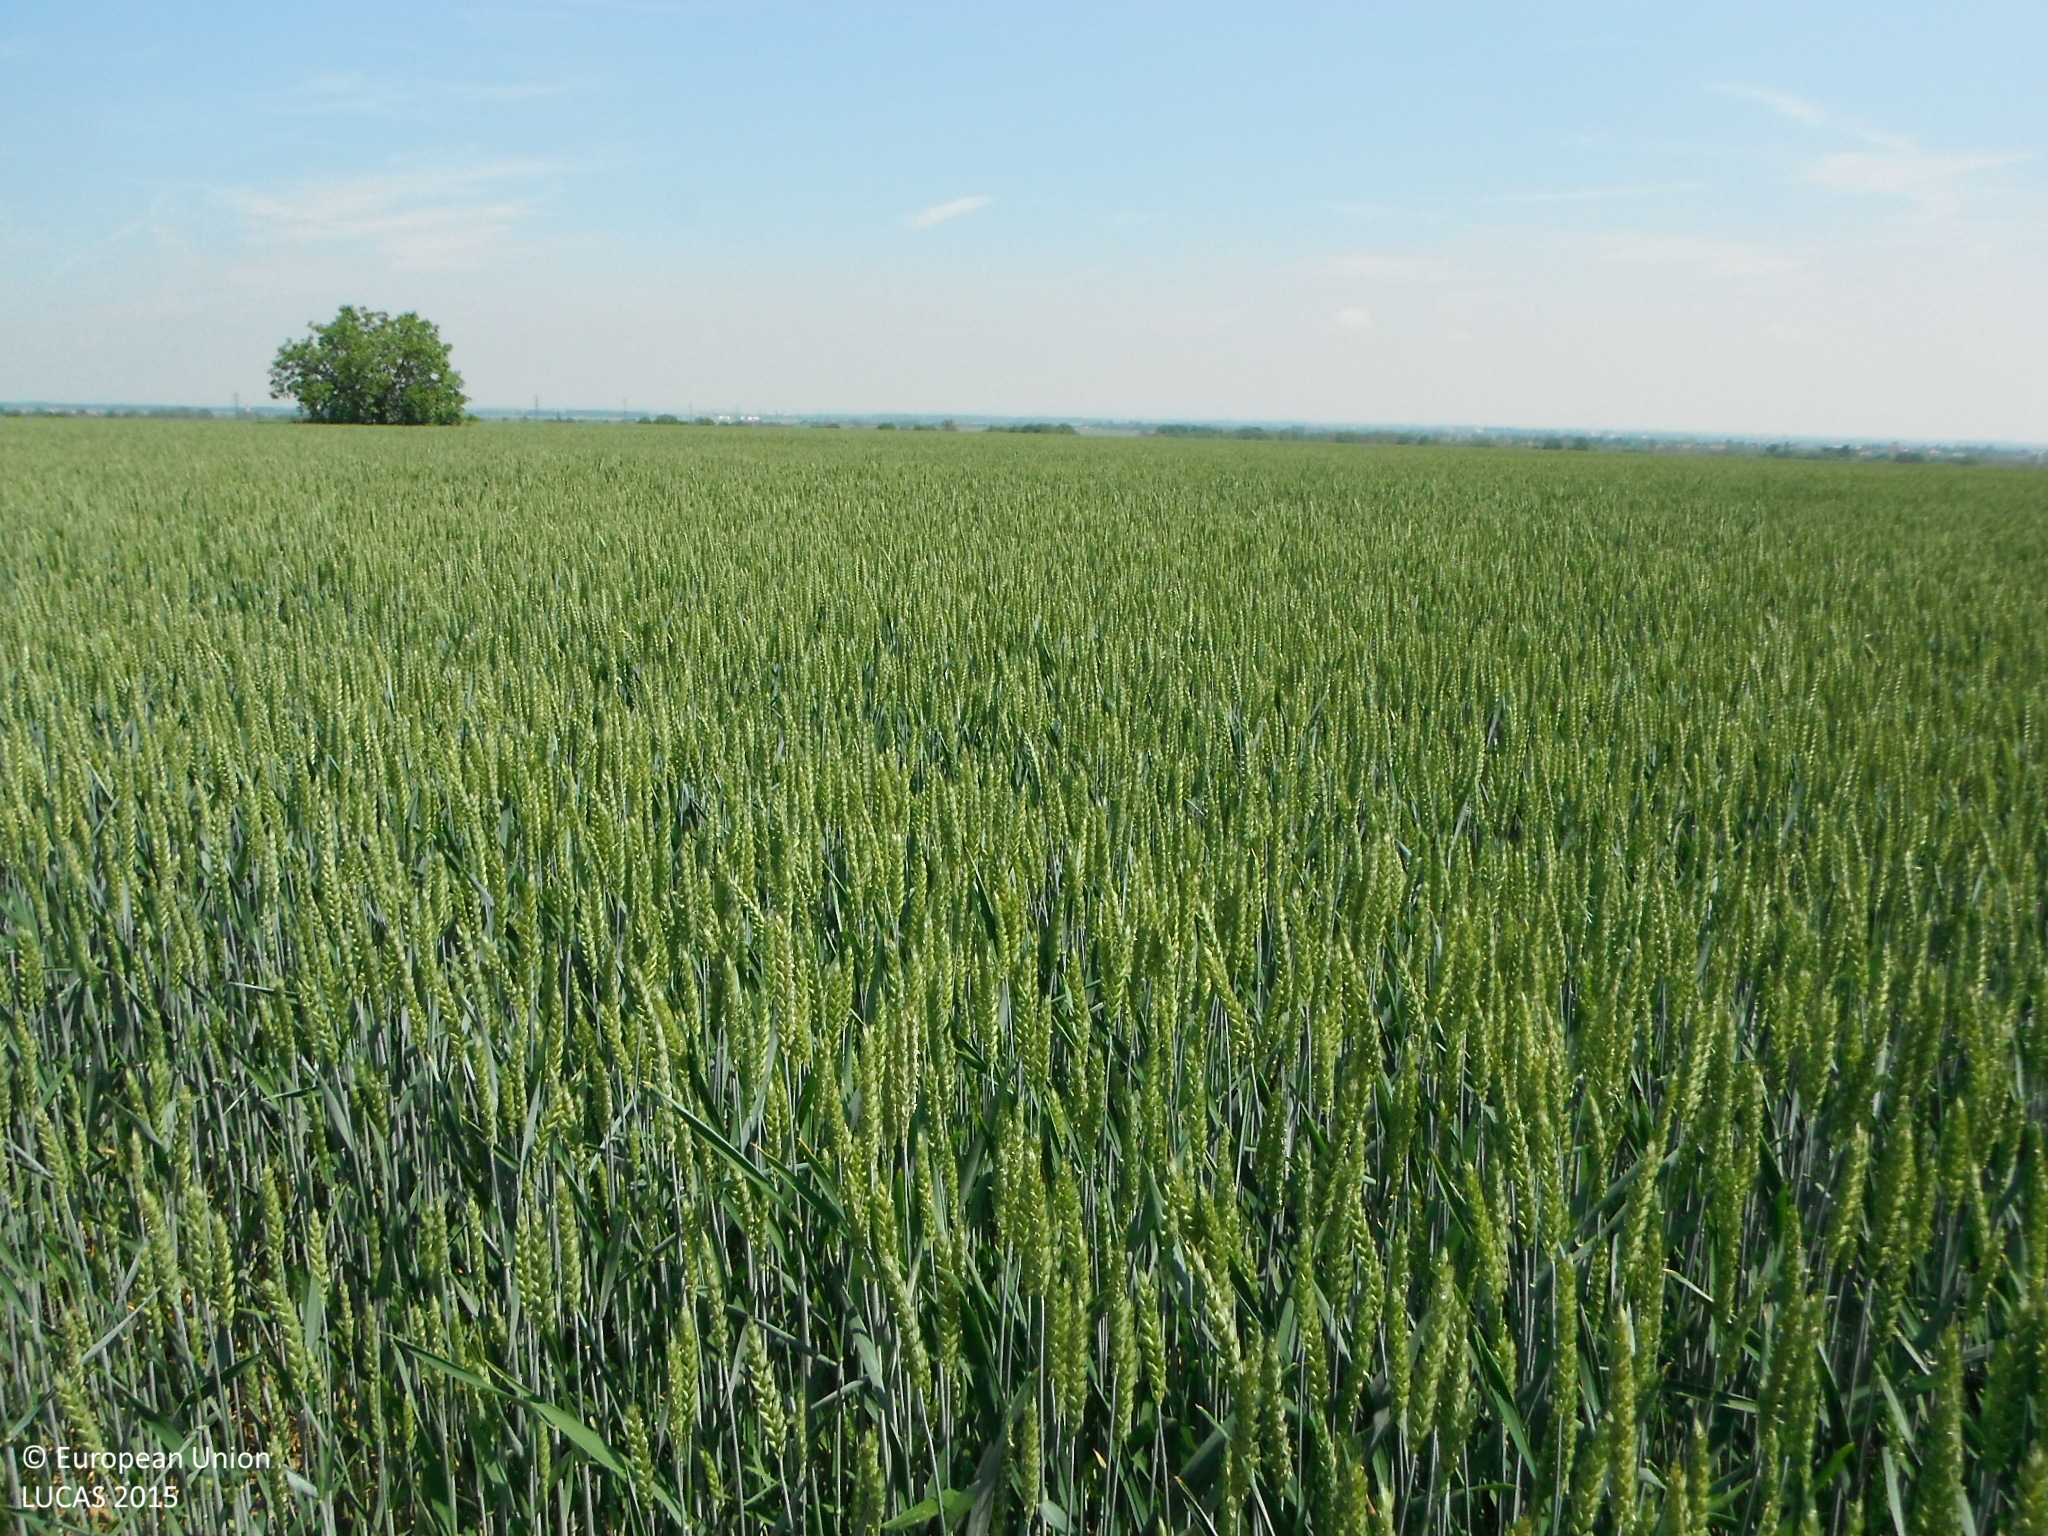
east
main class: Cropland
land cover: Common wheat
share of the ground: > 75 %
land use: Agriculture (excluding fallow land and kitchen gardens)
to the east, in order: Common wheat
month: June
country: SK
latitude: 48.3171
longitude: 17.4132
